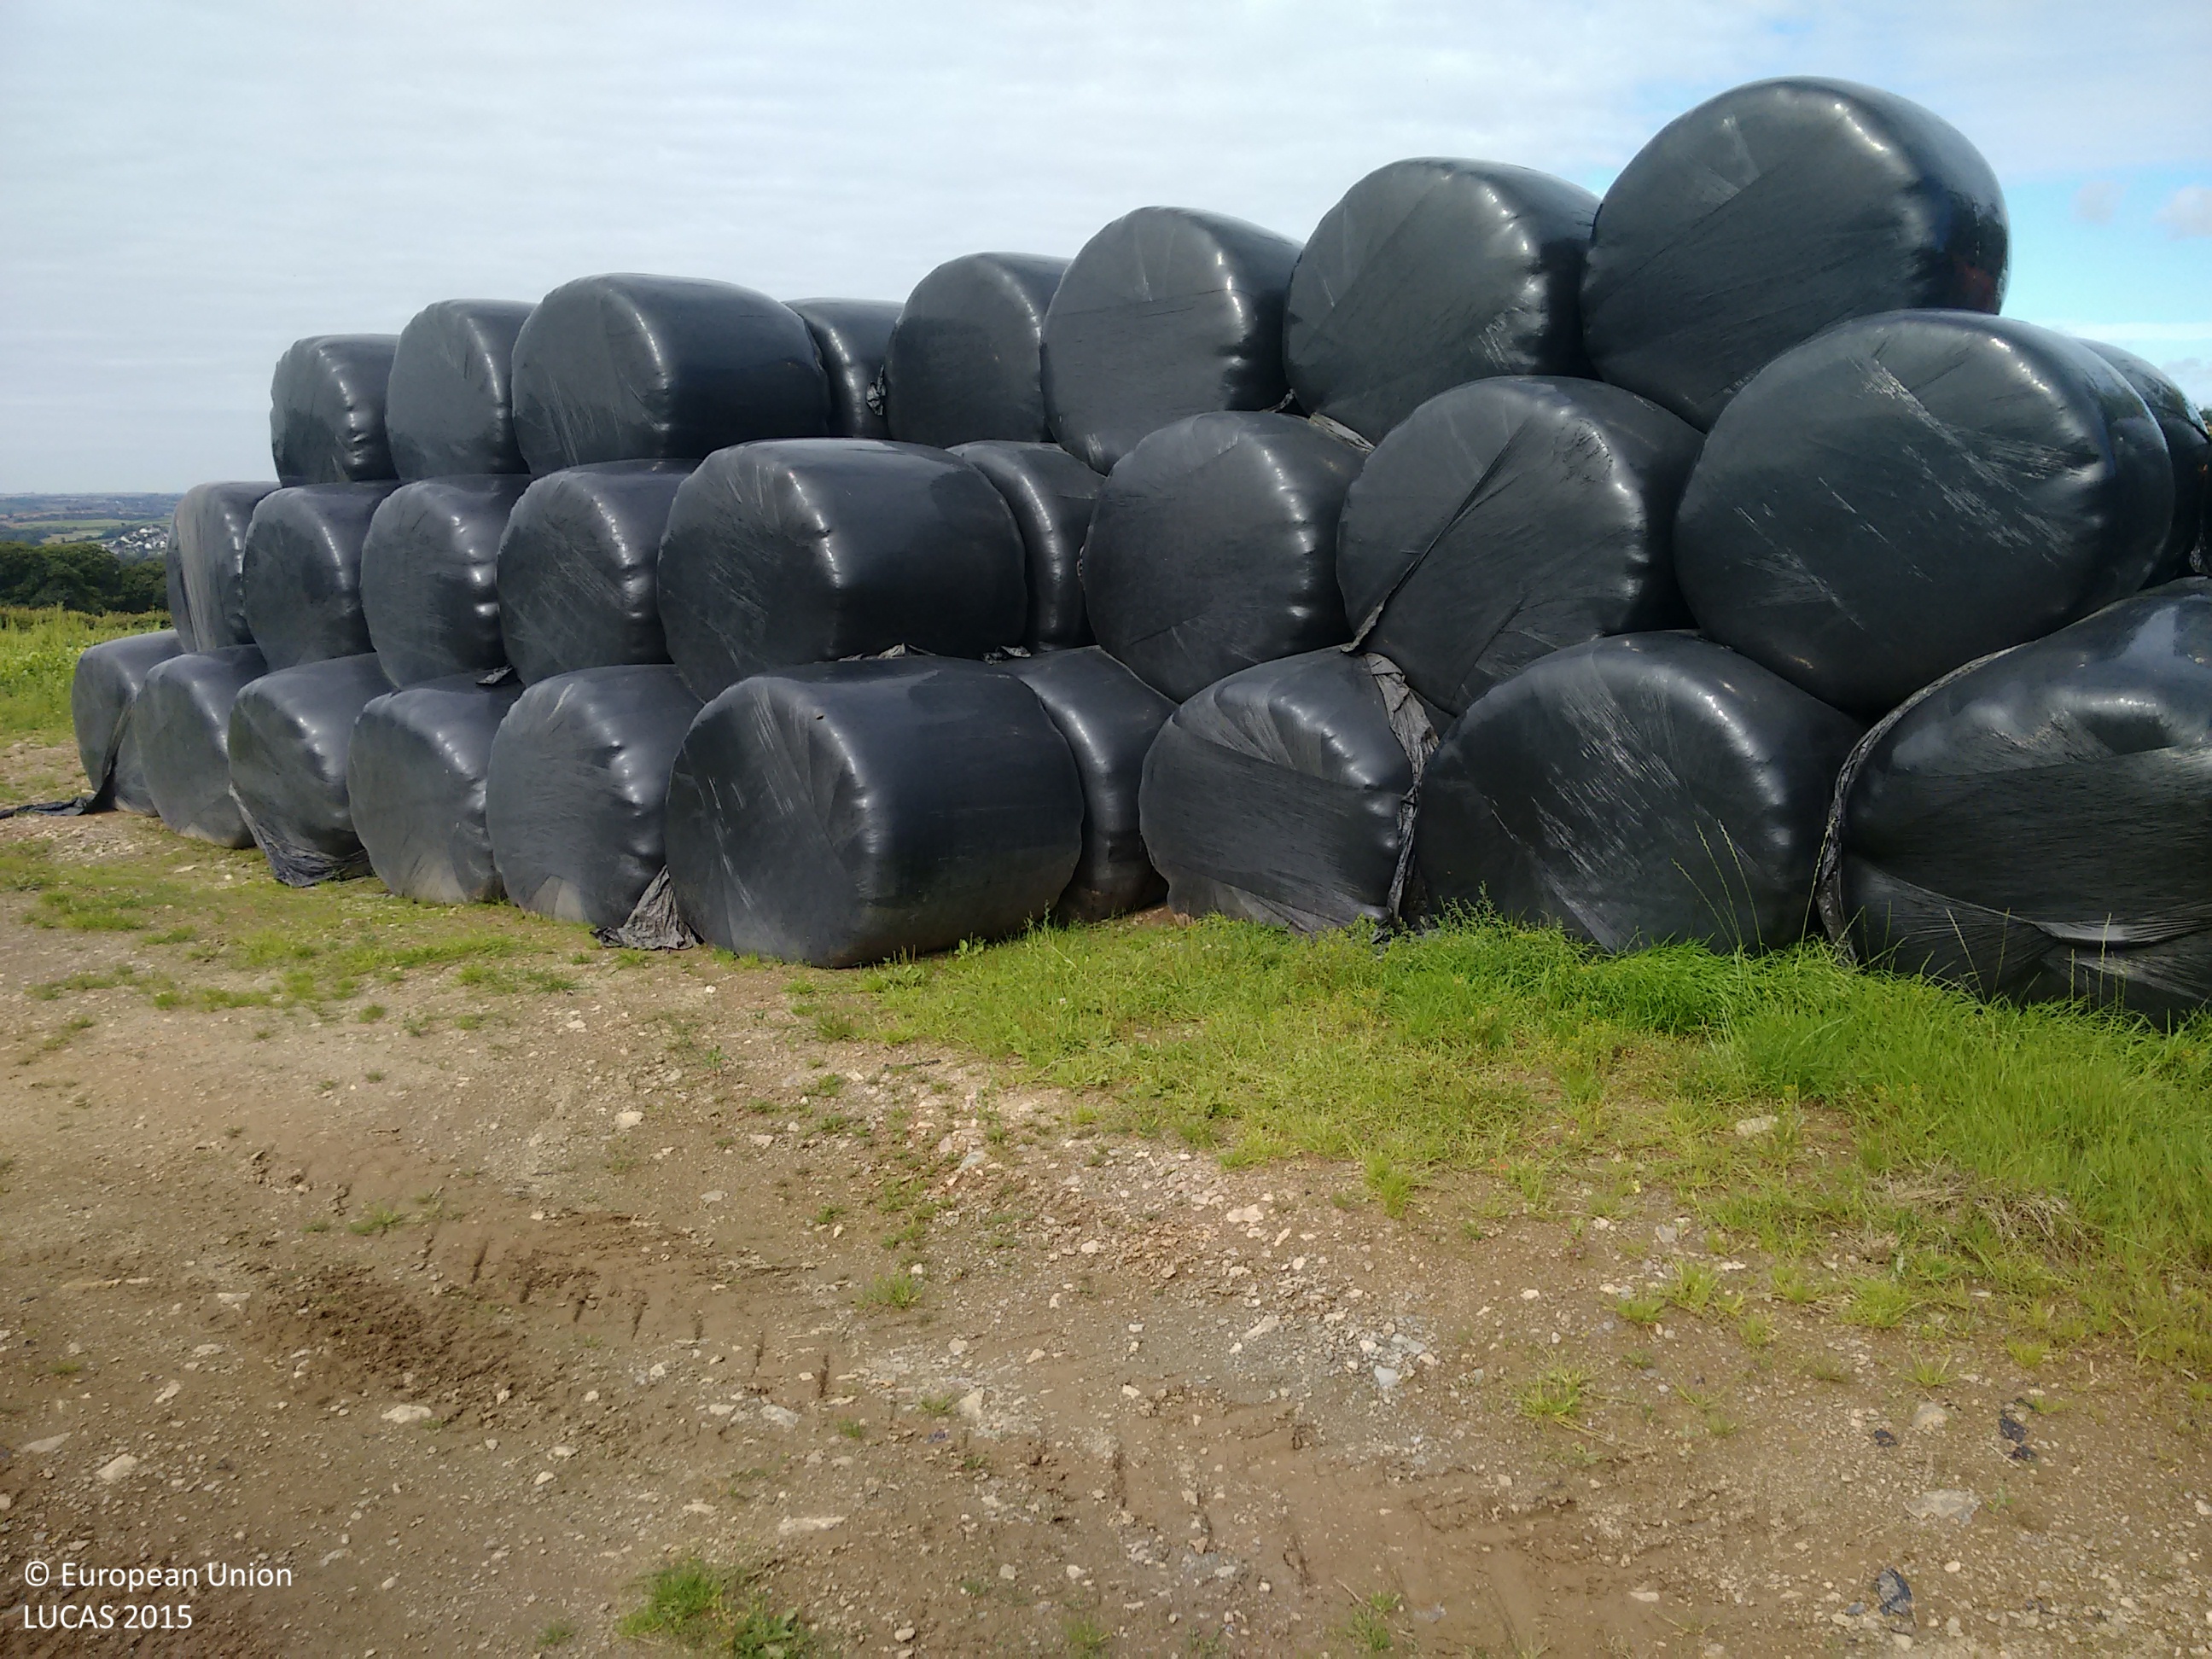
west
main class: Cropland
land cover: Sugar beet
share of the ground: > 75 %
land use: Agriculture (excluding fallow land and kitchen gardens)
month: August
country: GB
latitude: 50.4657
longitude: -4.1424
